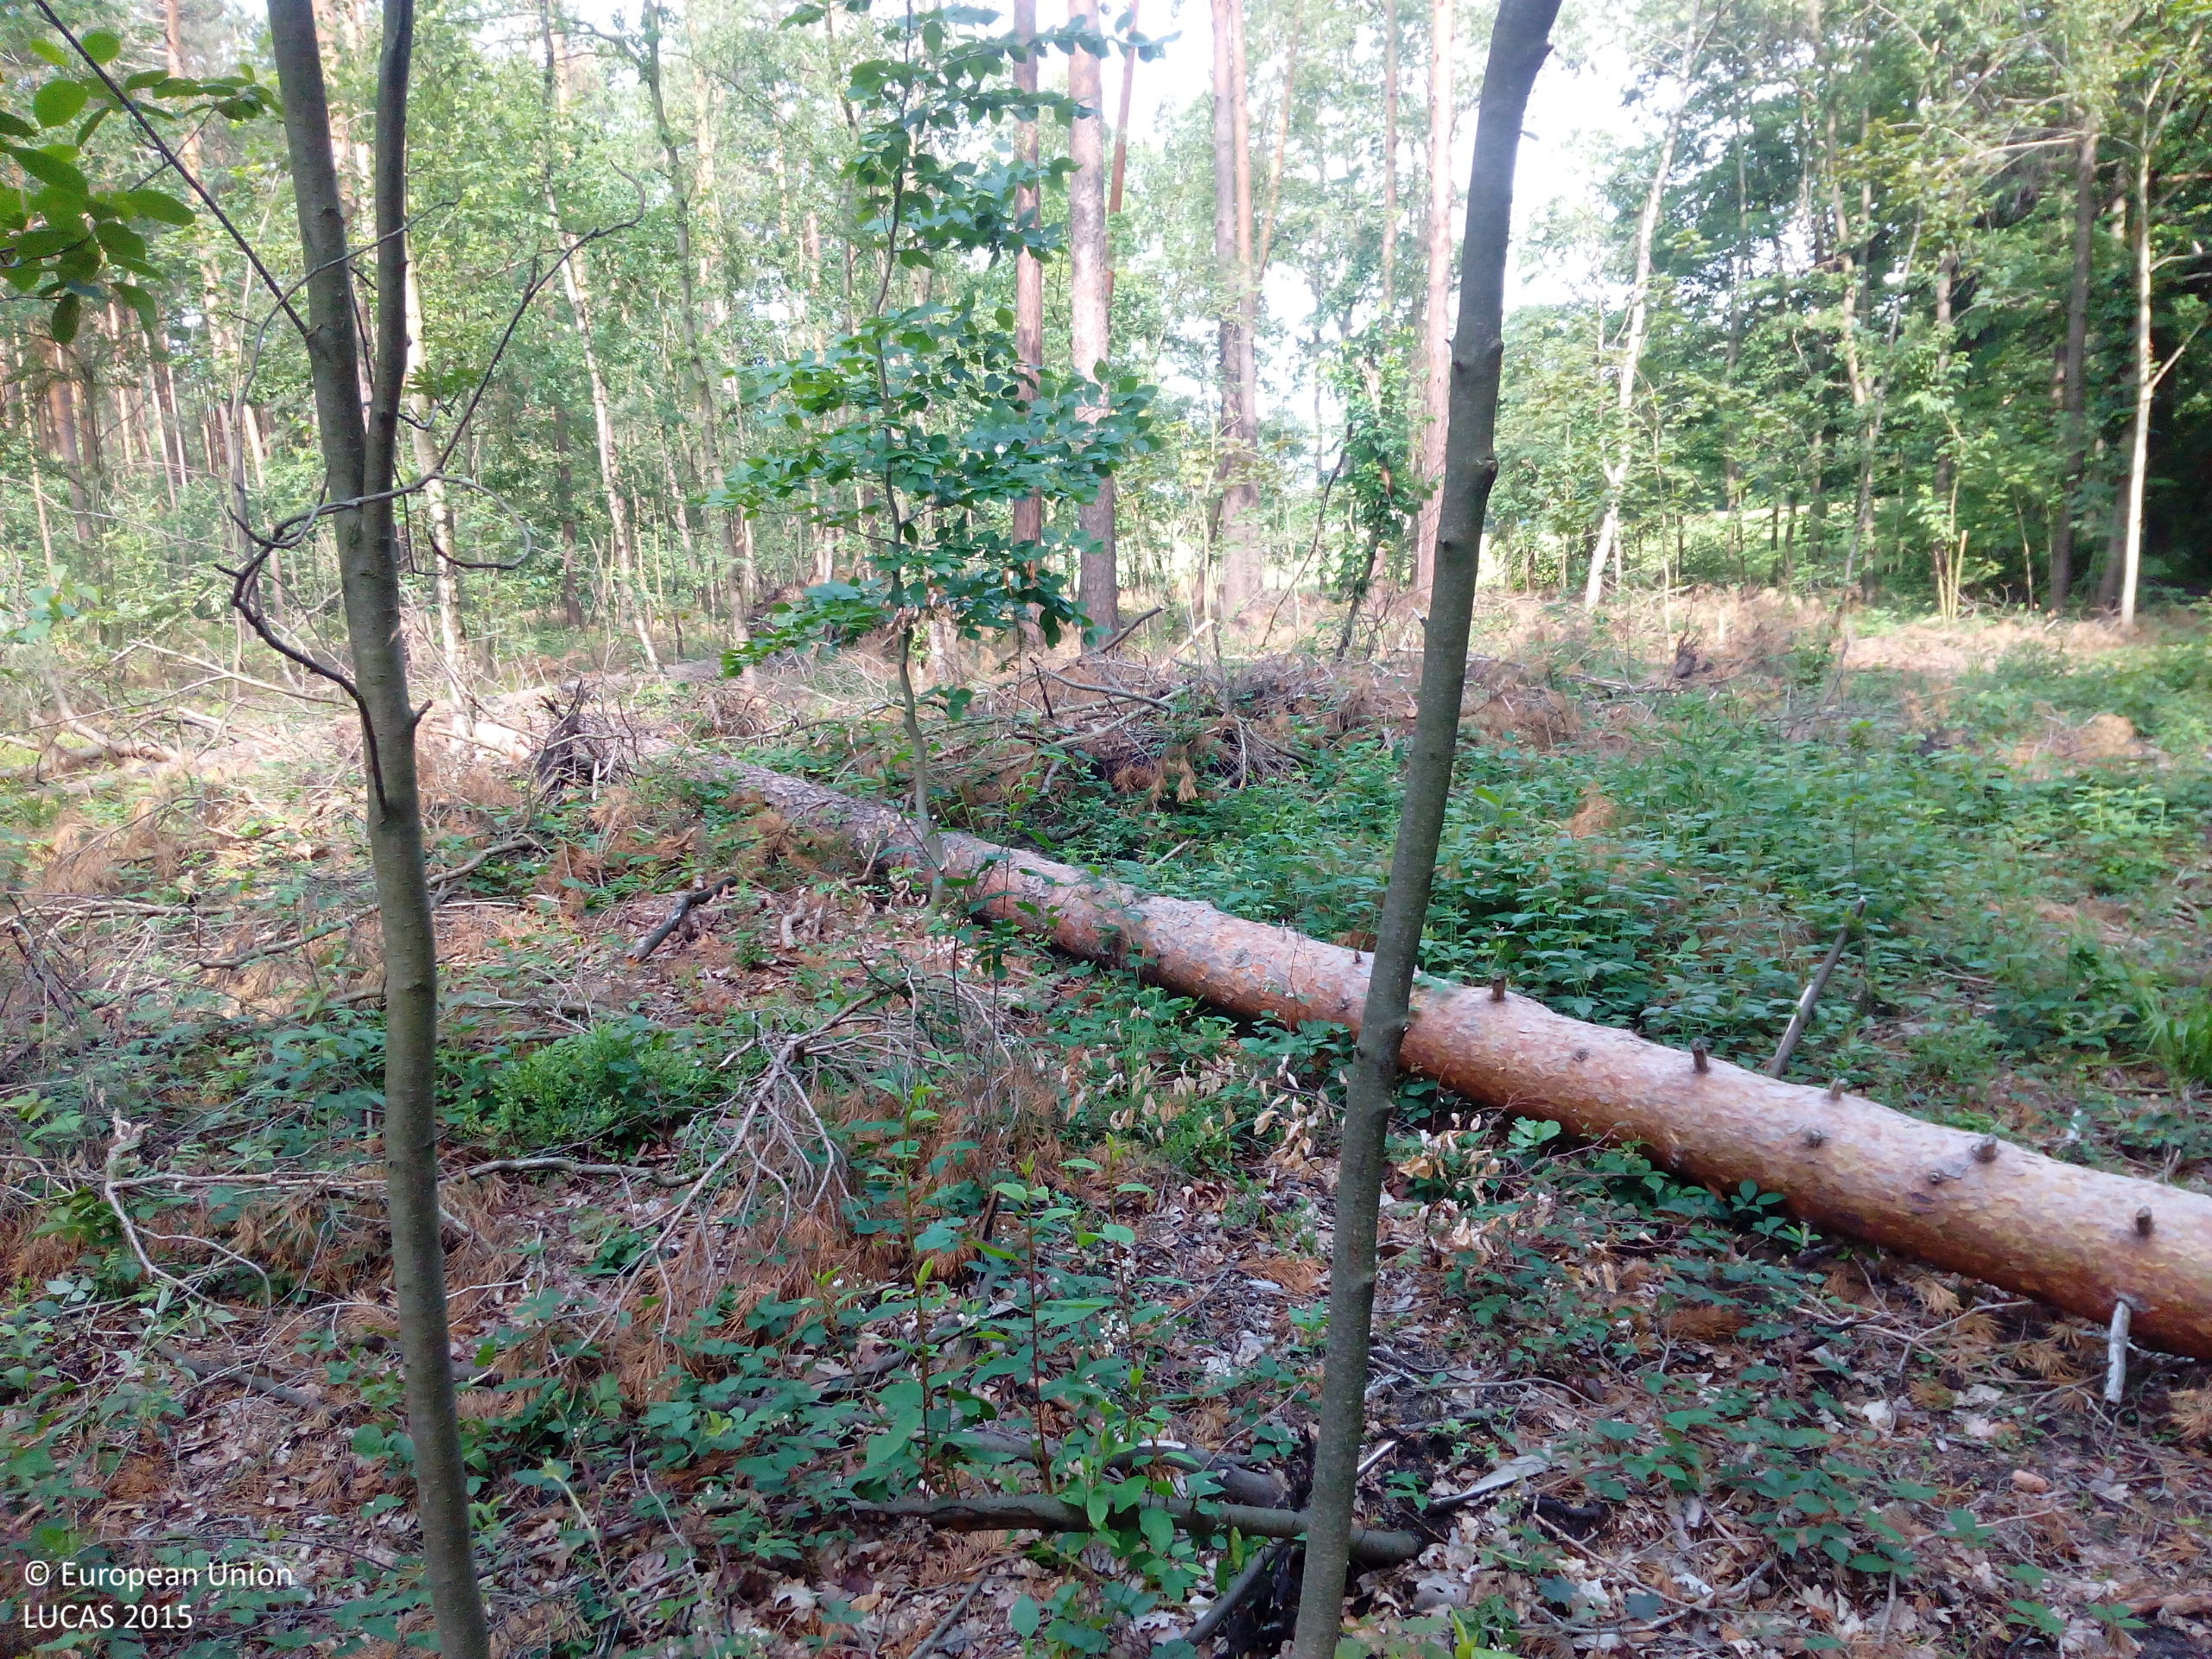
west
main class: Woodland
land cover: Pine dominated mixed woodland
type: hemiboreal forest and nemoral coniferous forest and mixed broadleaved-coniferous forest
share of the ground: 25 - 50 %
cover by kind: shrubs 35 %, coniferous forest trees 25 %, broadleaved forest trees 20 %, unconsolidated bare surface 20 %
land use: Forestry
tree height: > 5 m
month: June
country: DE
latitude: 51.2842
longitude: 14.0013
